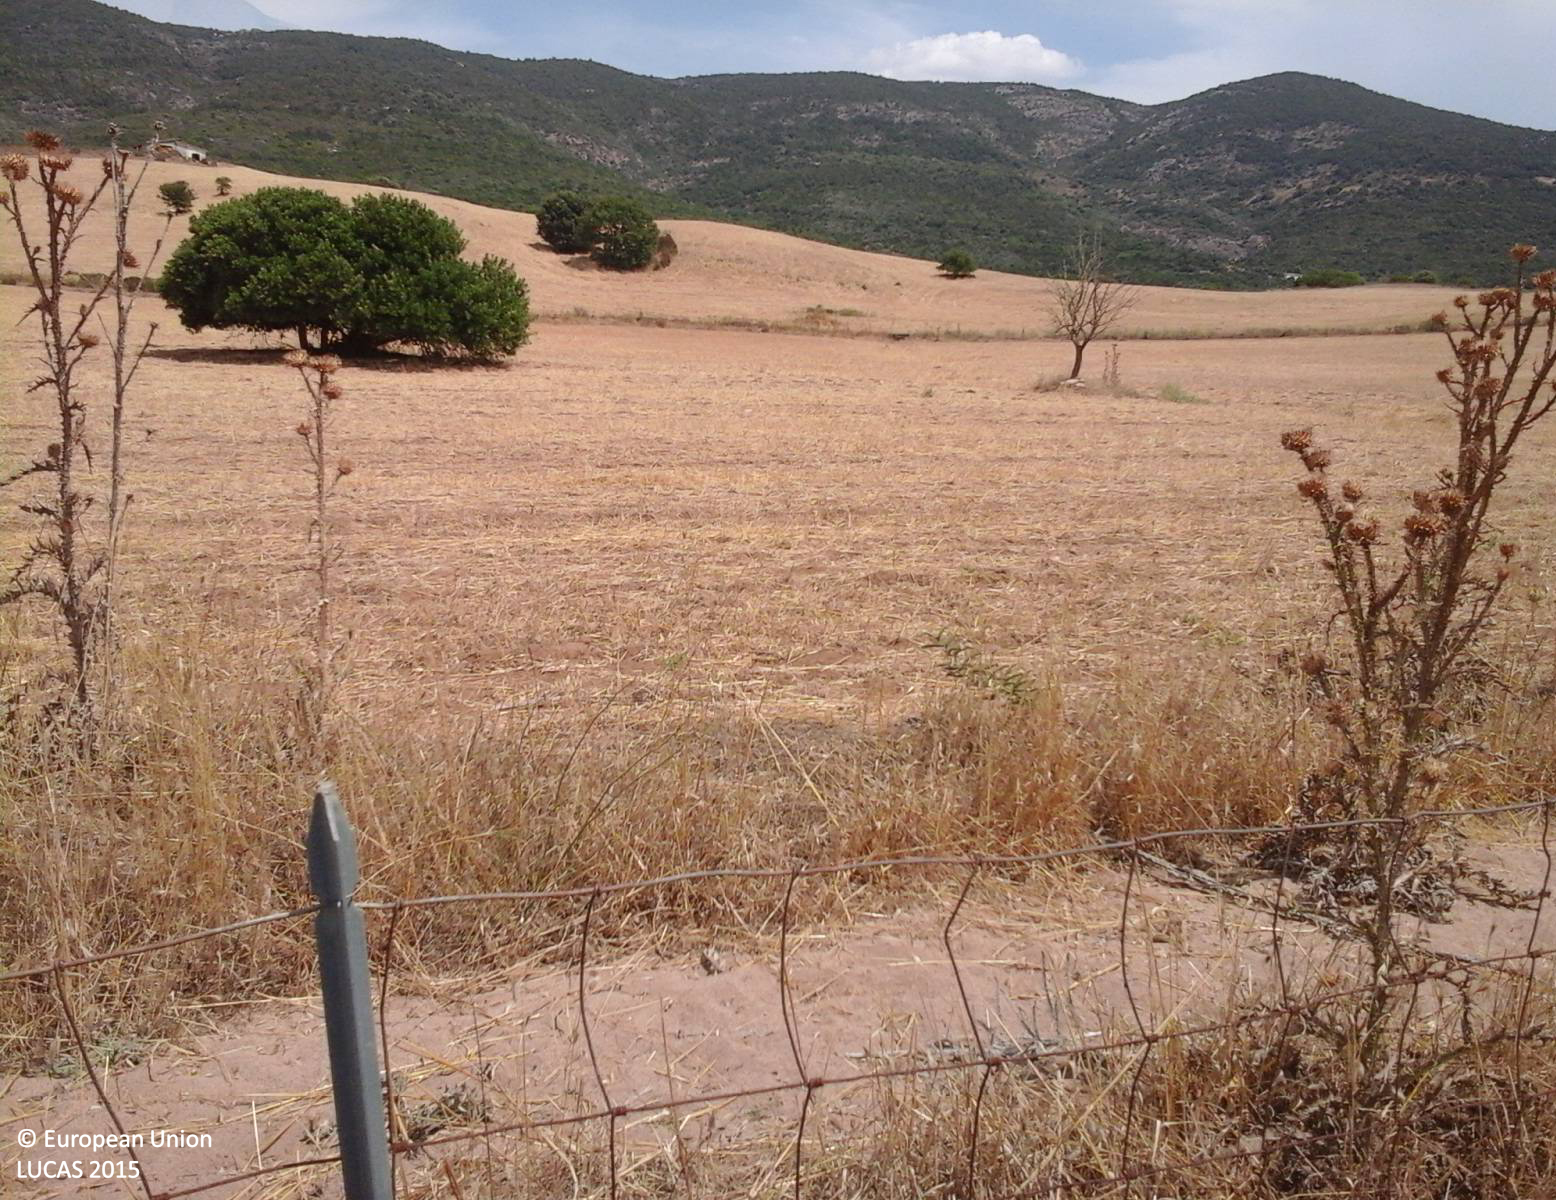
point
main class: Cropland
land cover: Temporary grasslands
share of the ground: > 75 %
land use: Agriculture (excluding fallow land and kitchen gardens)
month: July
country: IT
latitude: 39.7377
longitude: 9.0602
